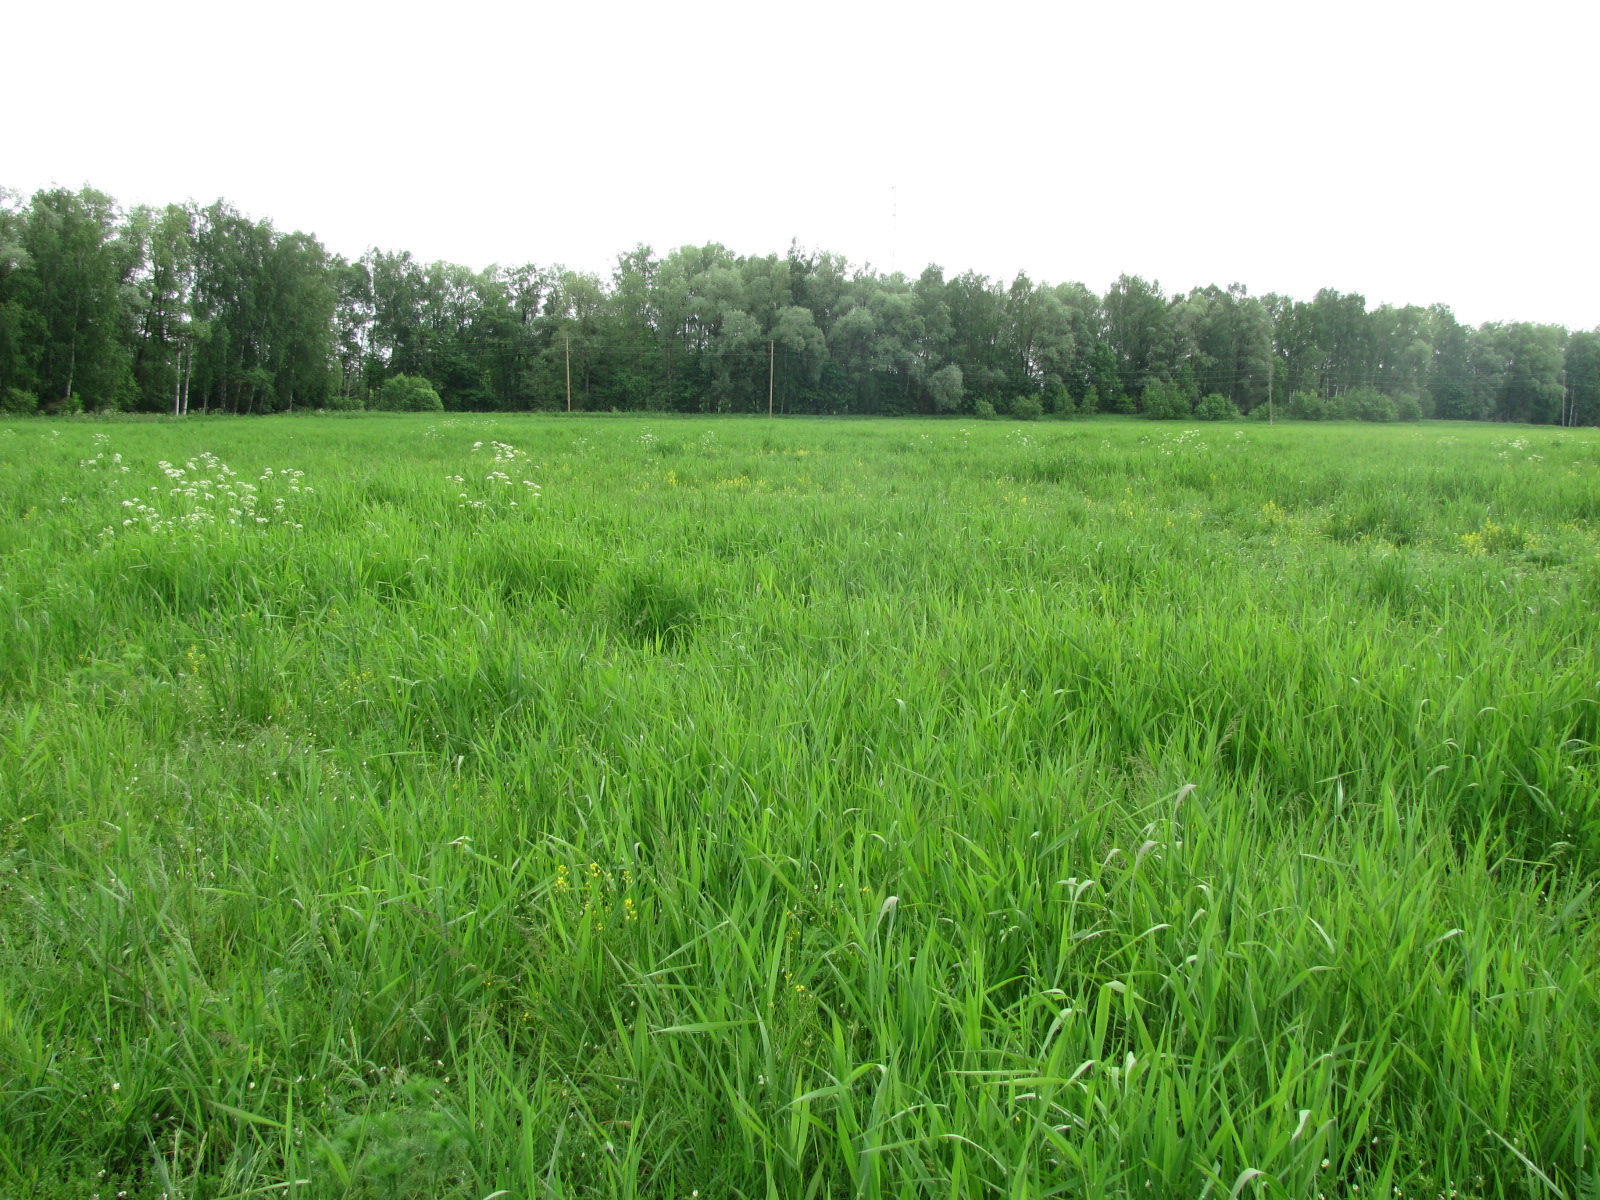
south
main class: Grassland
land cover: Grassland without tree/shrub cover
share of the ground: > 75 %
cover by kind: herbaceous plants 100 %
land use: Agriculture (excluding fallow land and kitchen gardens)
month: June
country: LV
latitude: 56.5912
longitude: 24.4408
